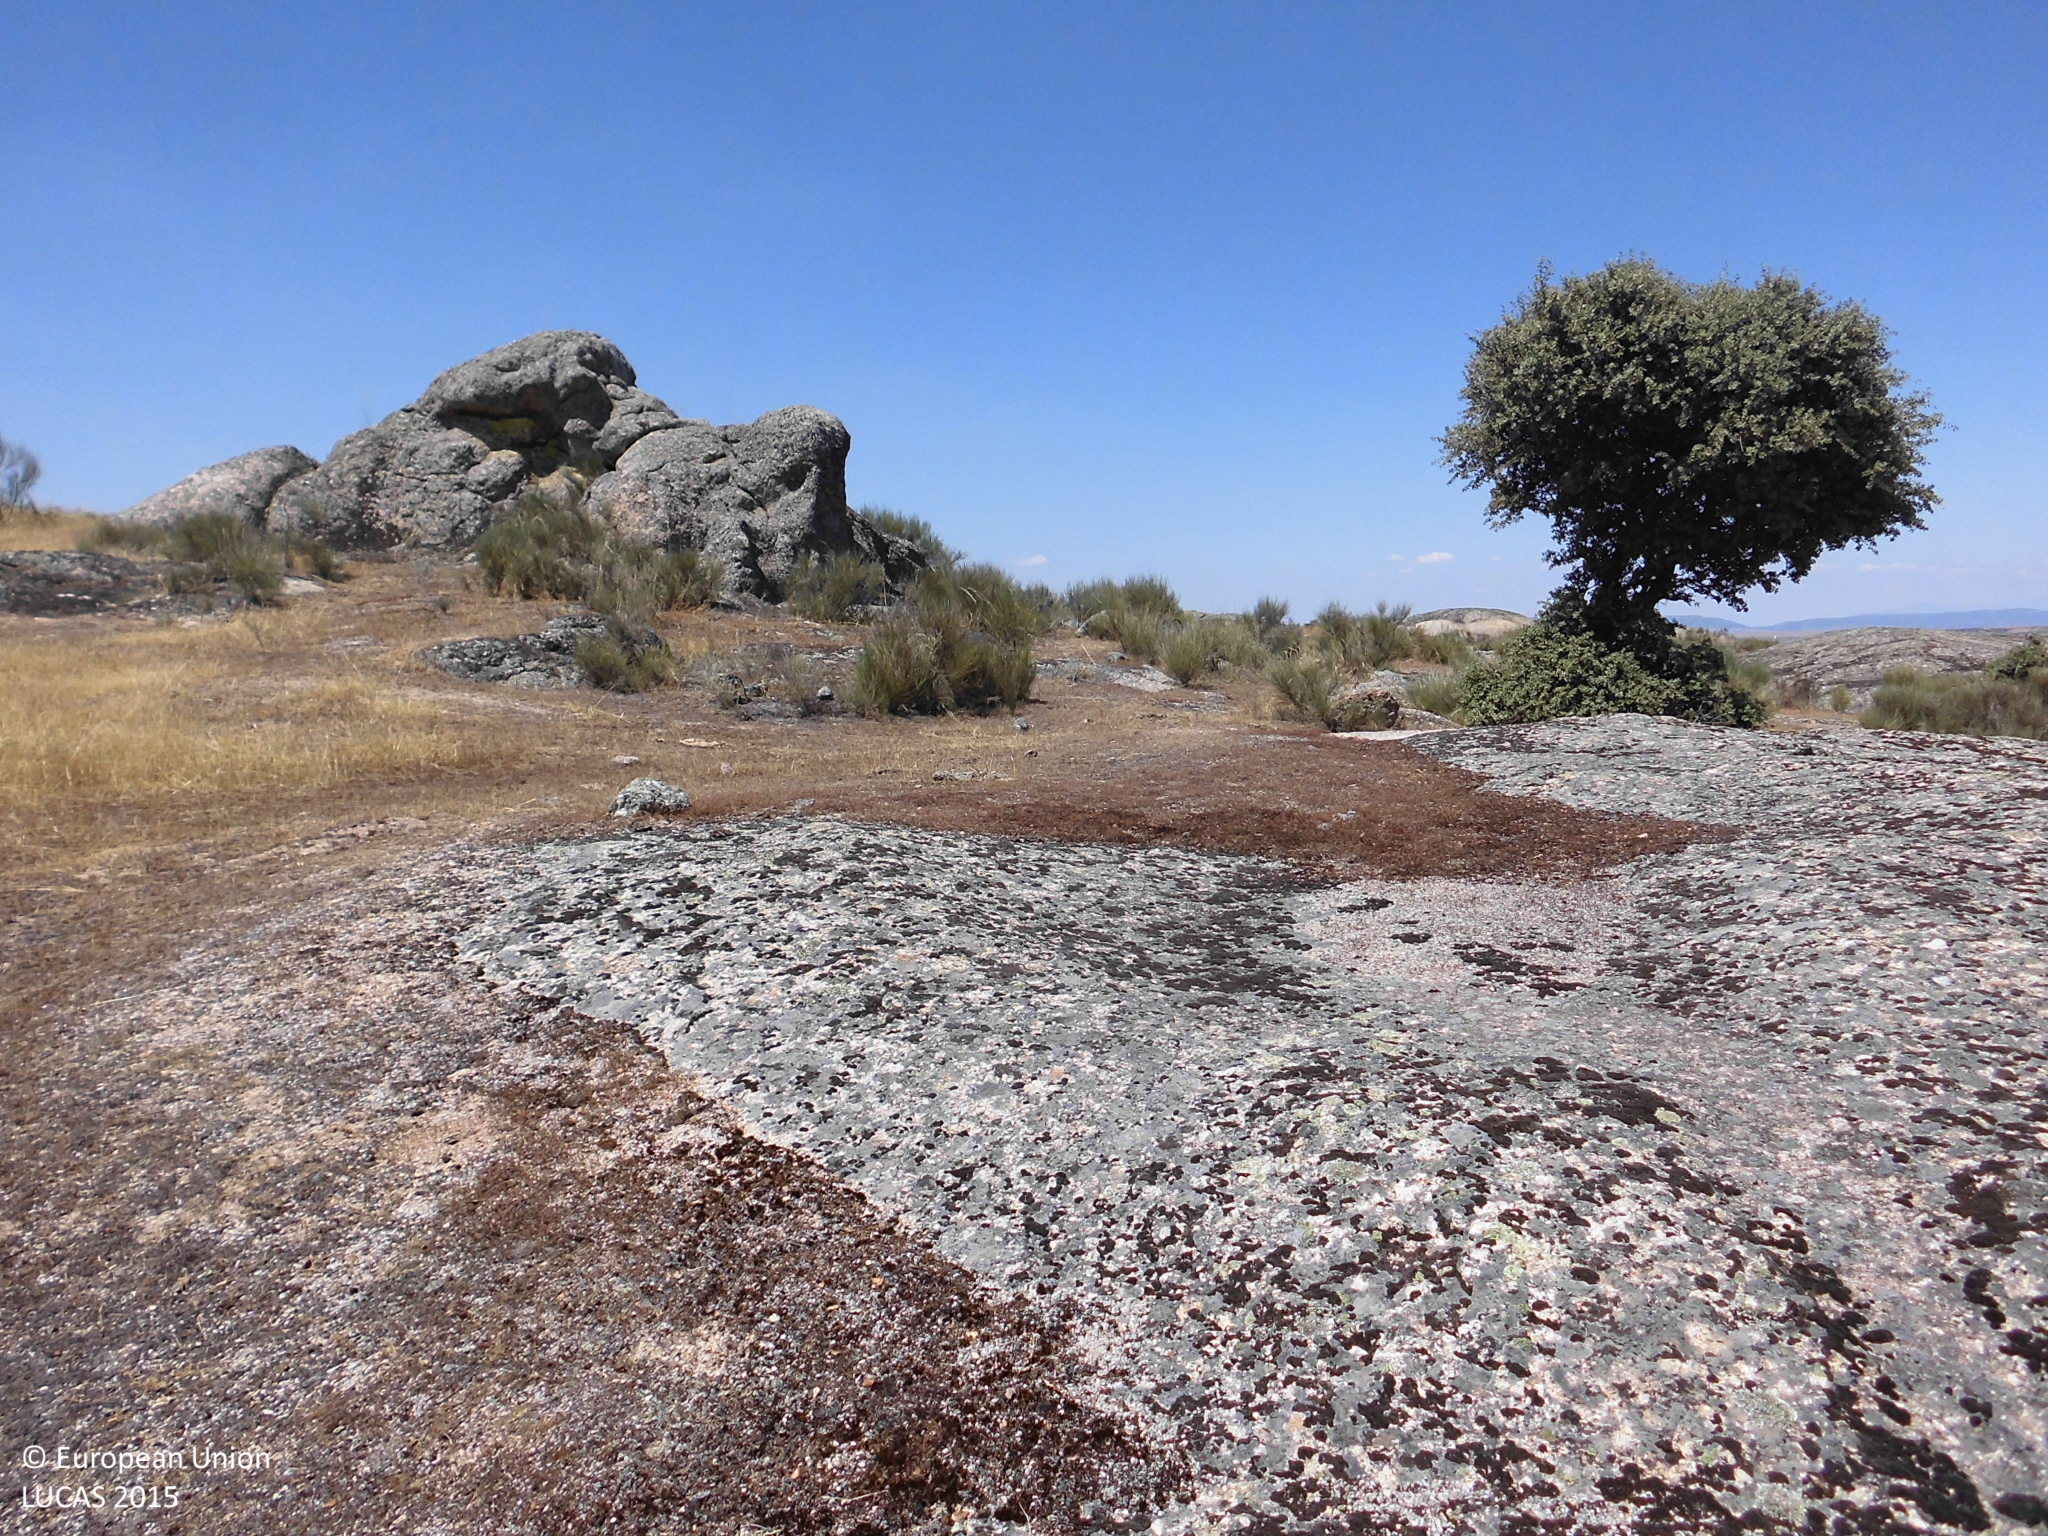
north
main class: Grassland
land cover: Grassland without tree/shrub cover
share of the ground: 25 - 50 %
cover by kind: consolidated bare surface 60 %, herbaceous plants 40 %
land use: Agriculture (excluding fallow land and kitchen gardens)
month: June
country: ES
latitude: 39.6074
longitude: -6.4354
